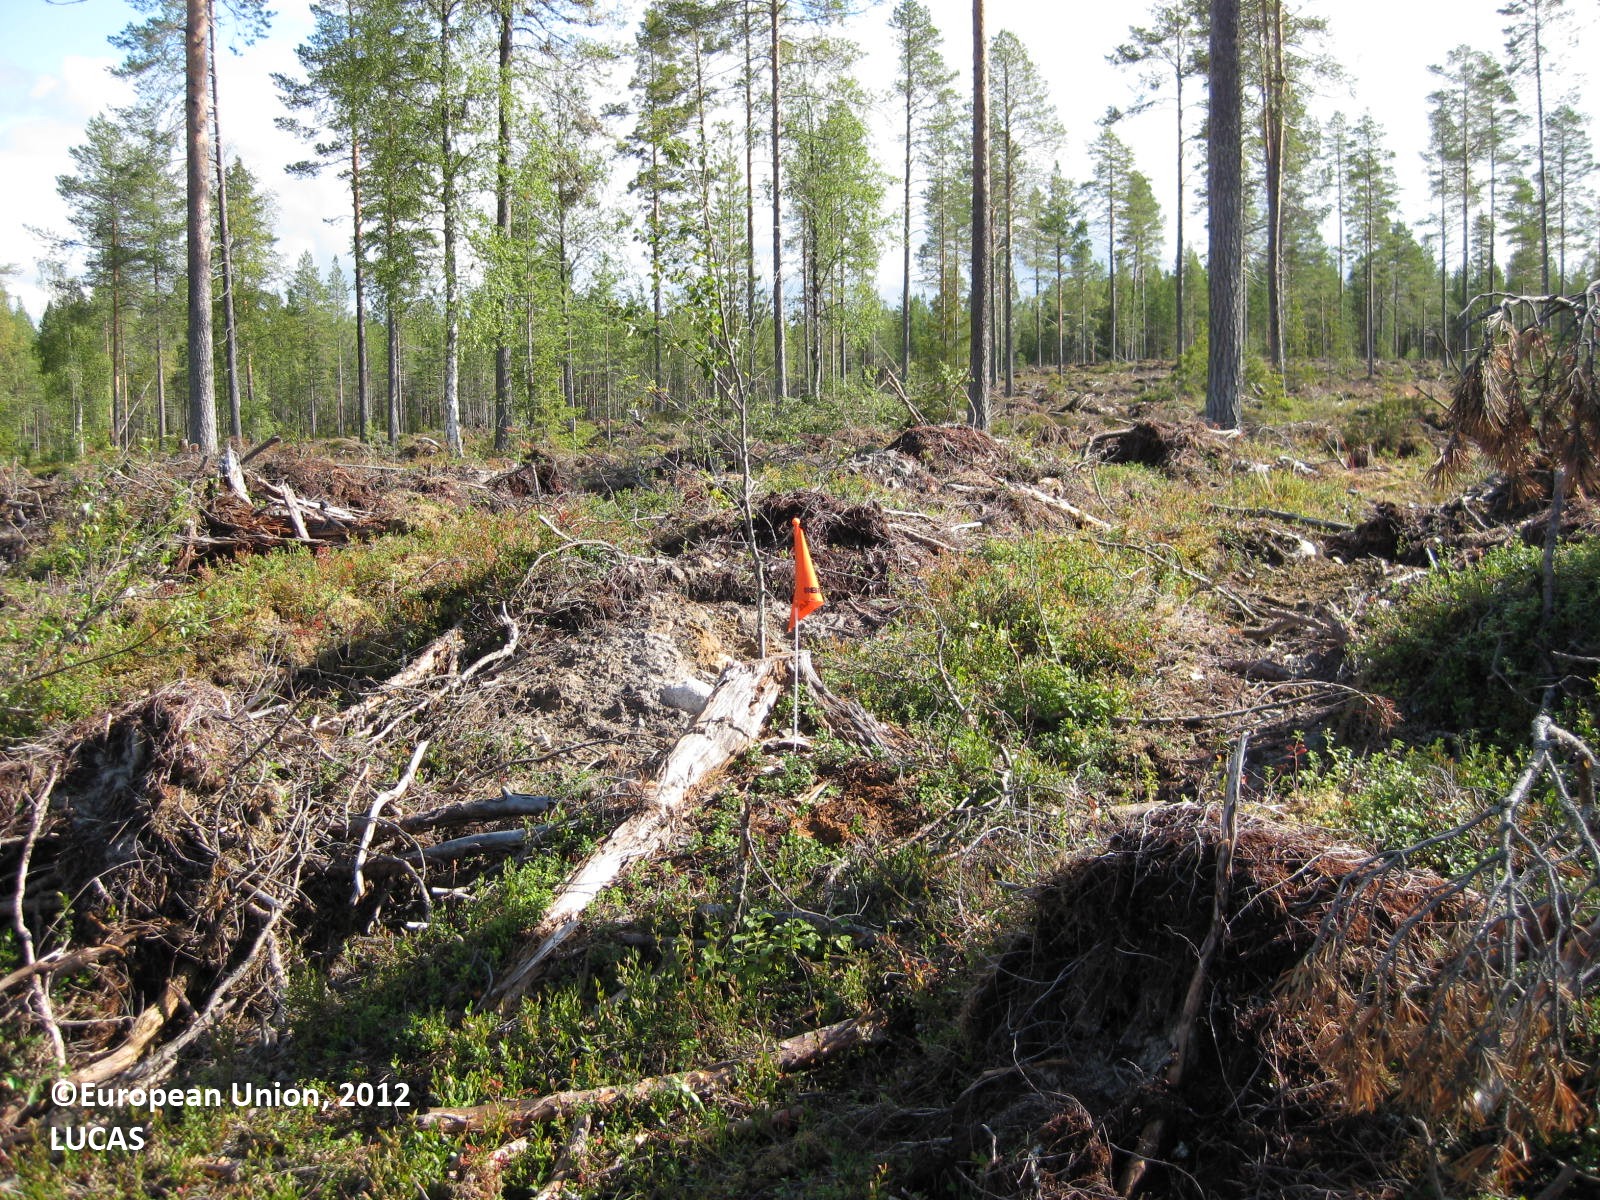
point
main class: Woodland
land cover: Pine dominated coniferous woodland
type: boreal forest
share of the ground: 10 - 25 %
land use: Forestry
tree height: > 5 m
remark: Clear cut
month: August
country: FI
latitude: 66.1532
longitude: 28.8498
